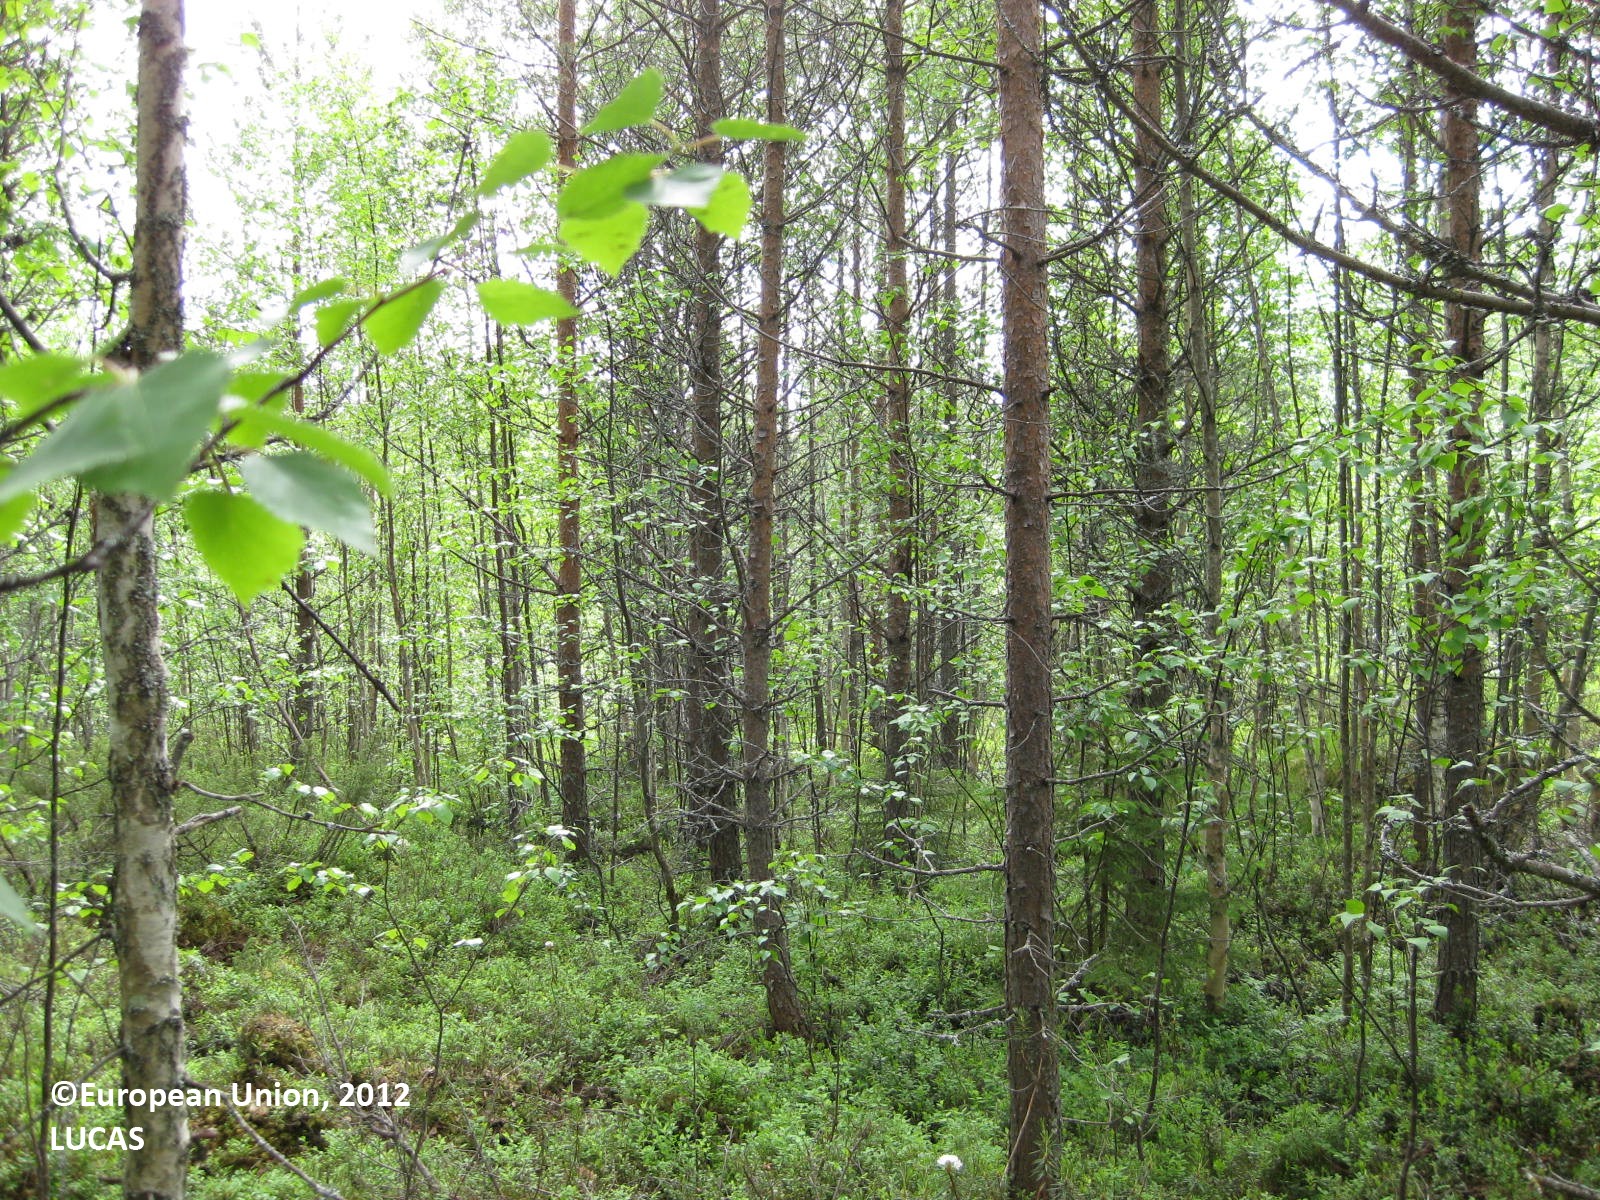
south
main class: Woodland
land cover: Pine dominated mixed woodland
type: boreal forest
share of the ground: > 75 %
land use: Forestry
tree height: > 5 m
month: June
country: FI
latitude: 65.3097
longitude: 28.1980
